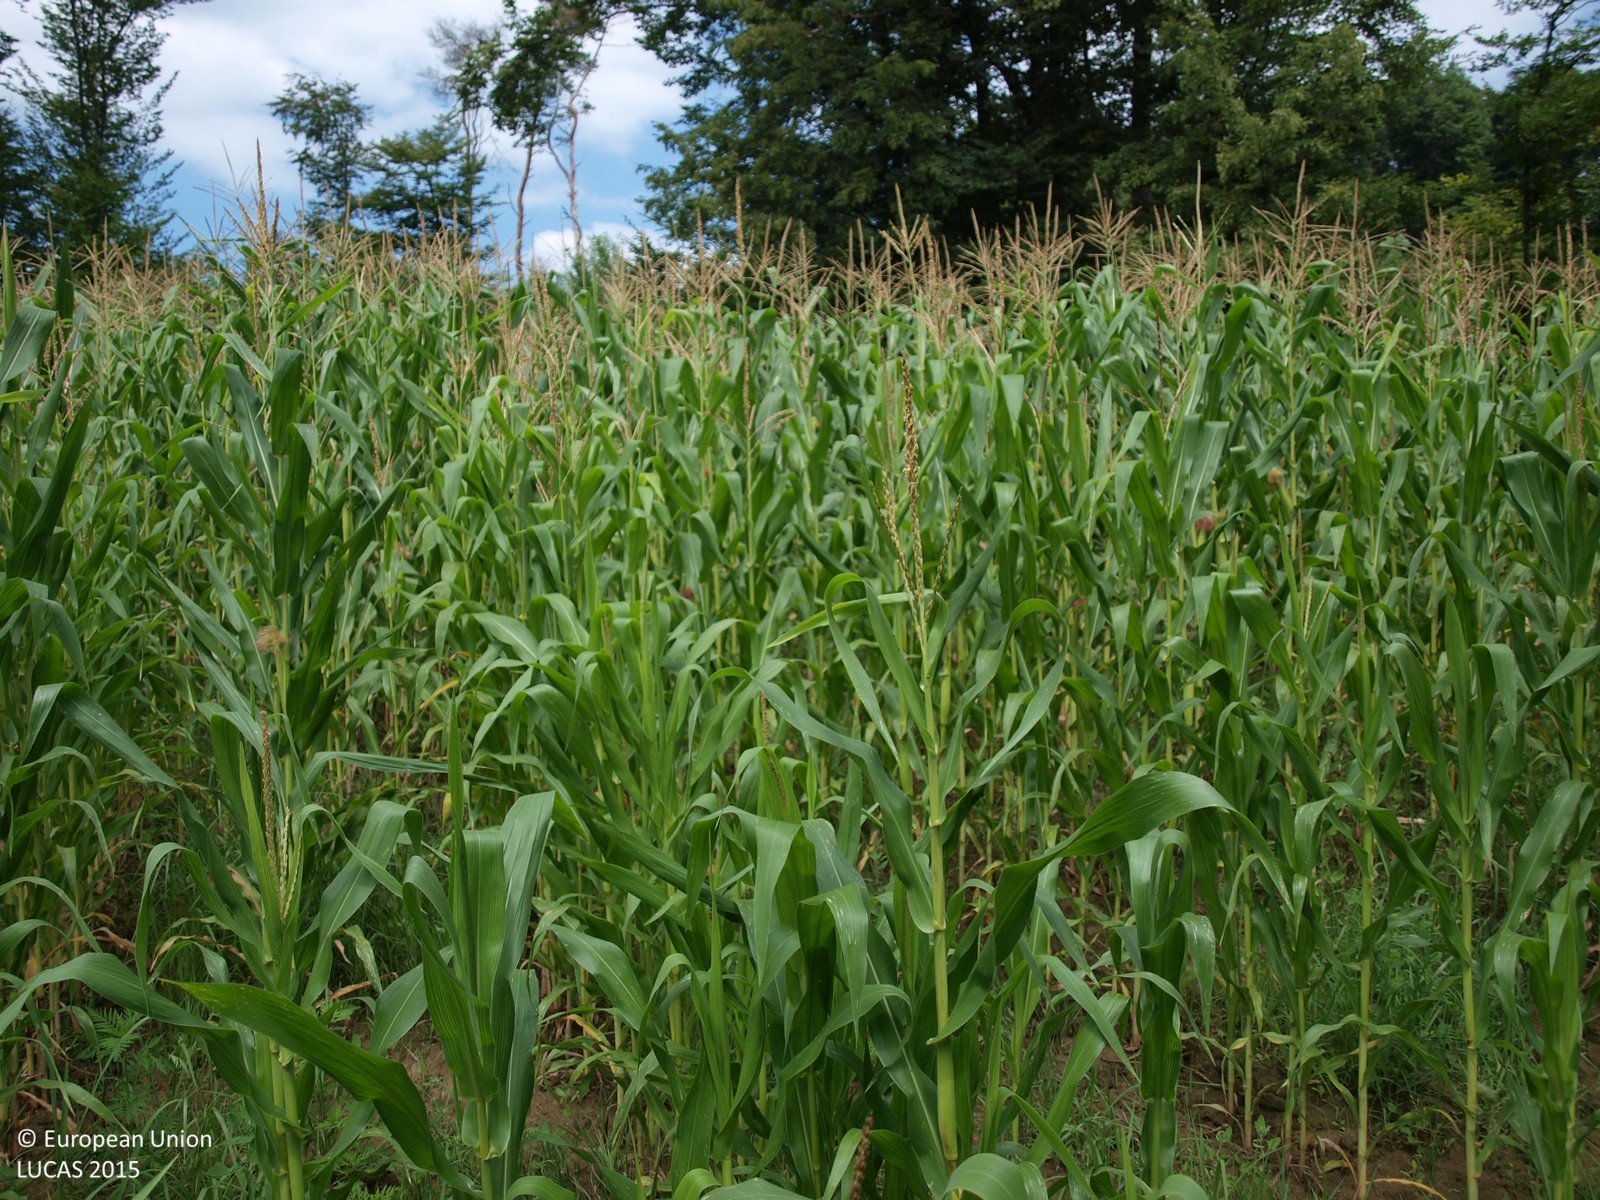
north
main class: Cropland
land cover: Maize
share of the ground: > 75 %
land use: Agriculture (excluding fallow land and kitchen gardens)
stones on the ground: < 10 %
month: August
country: HR
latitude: 45.9631
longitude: 16.3608
